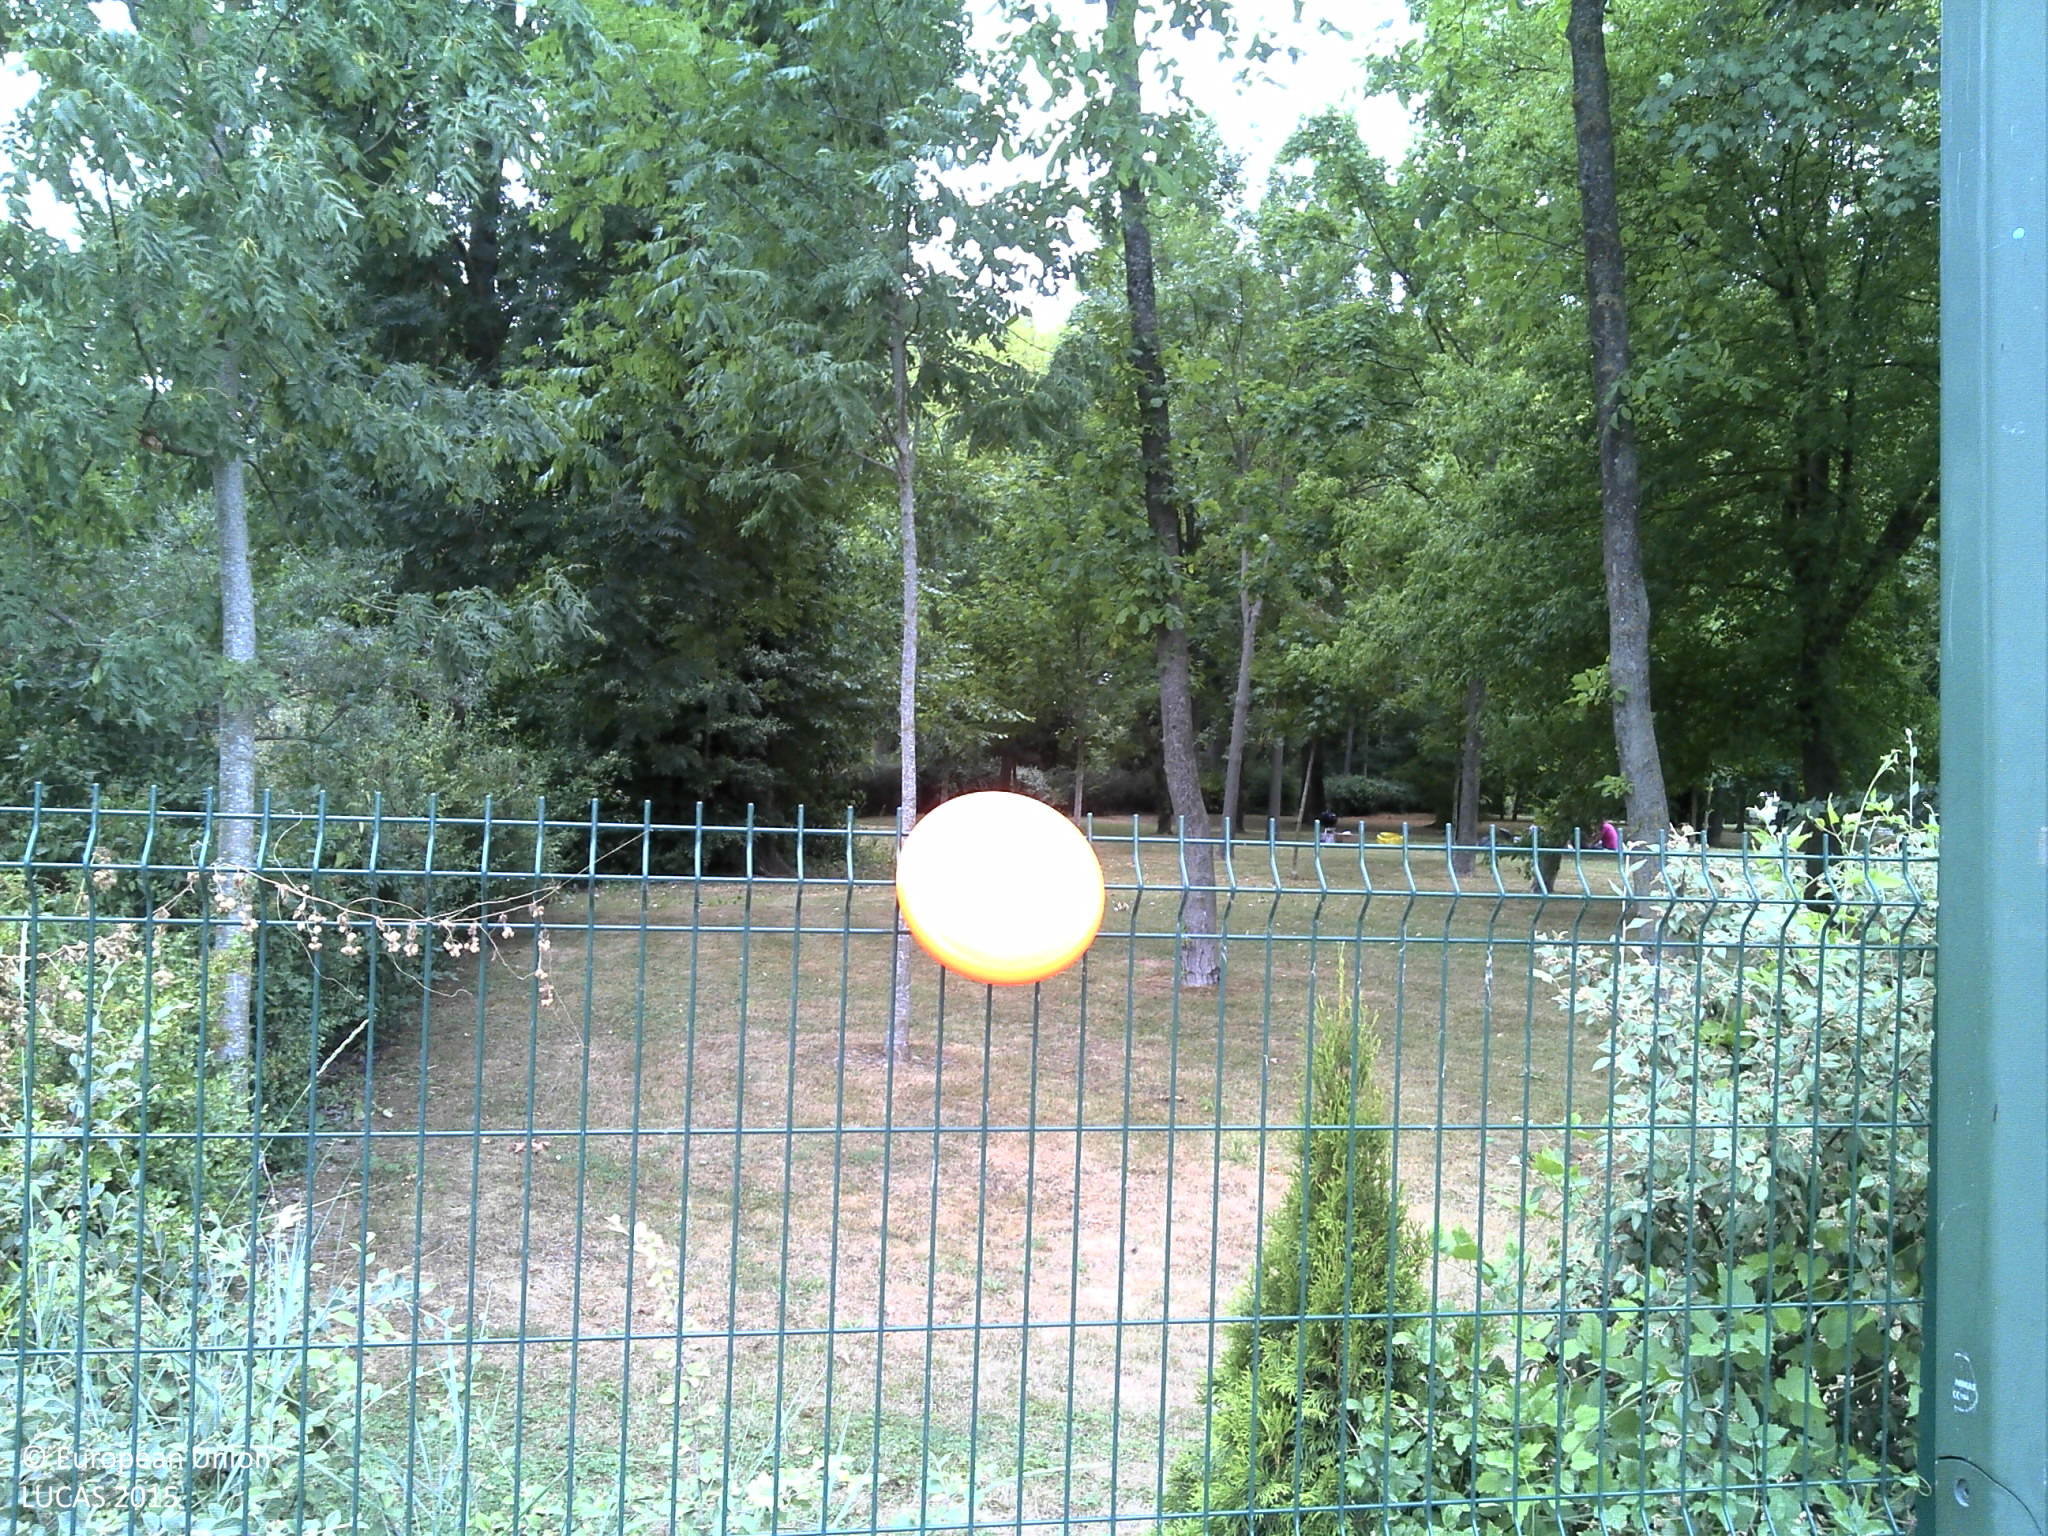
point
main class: Woodland
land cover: Broadleaved woodland
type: floodplain forest
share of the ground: > 75 %
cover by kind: broadleaved forest trees 70 %, herbaceous plants 30 %
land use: Amenities, museums, leisure
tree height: > 5 m
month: July
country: FR
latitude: 48.5996
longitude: 2.4903
